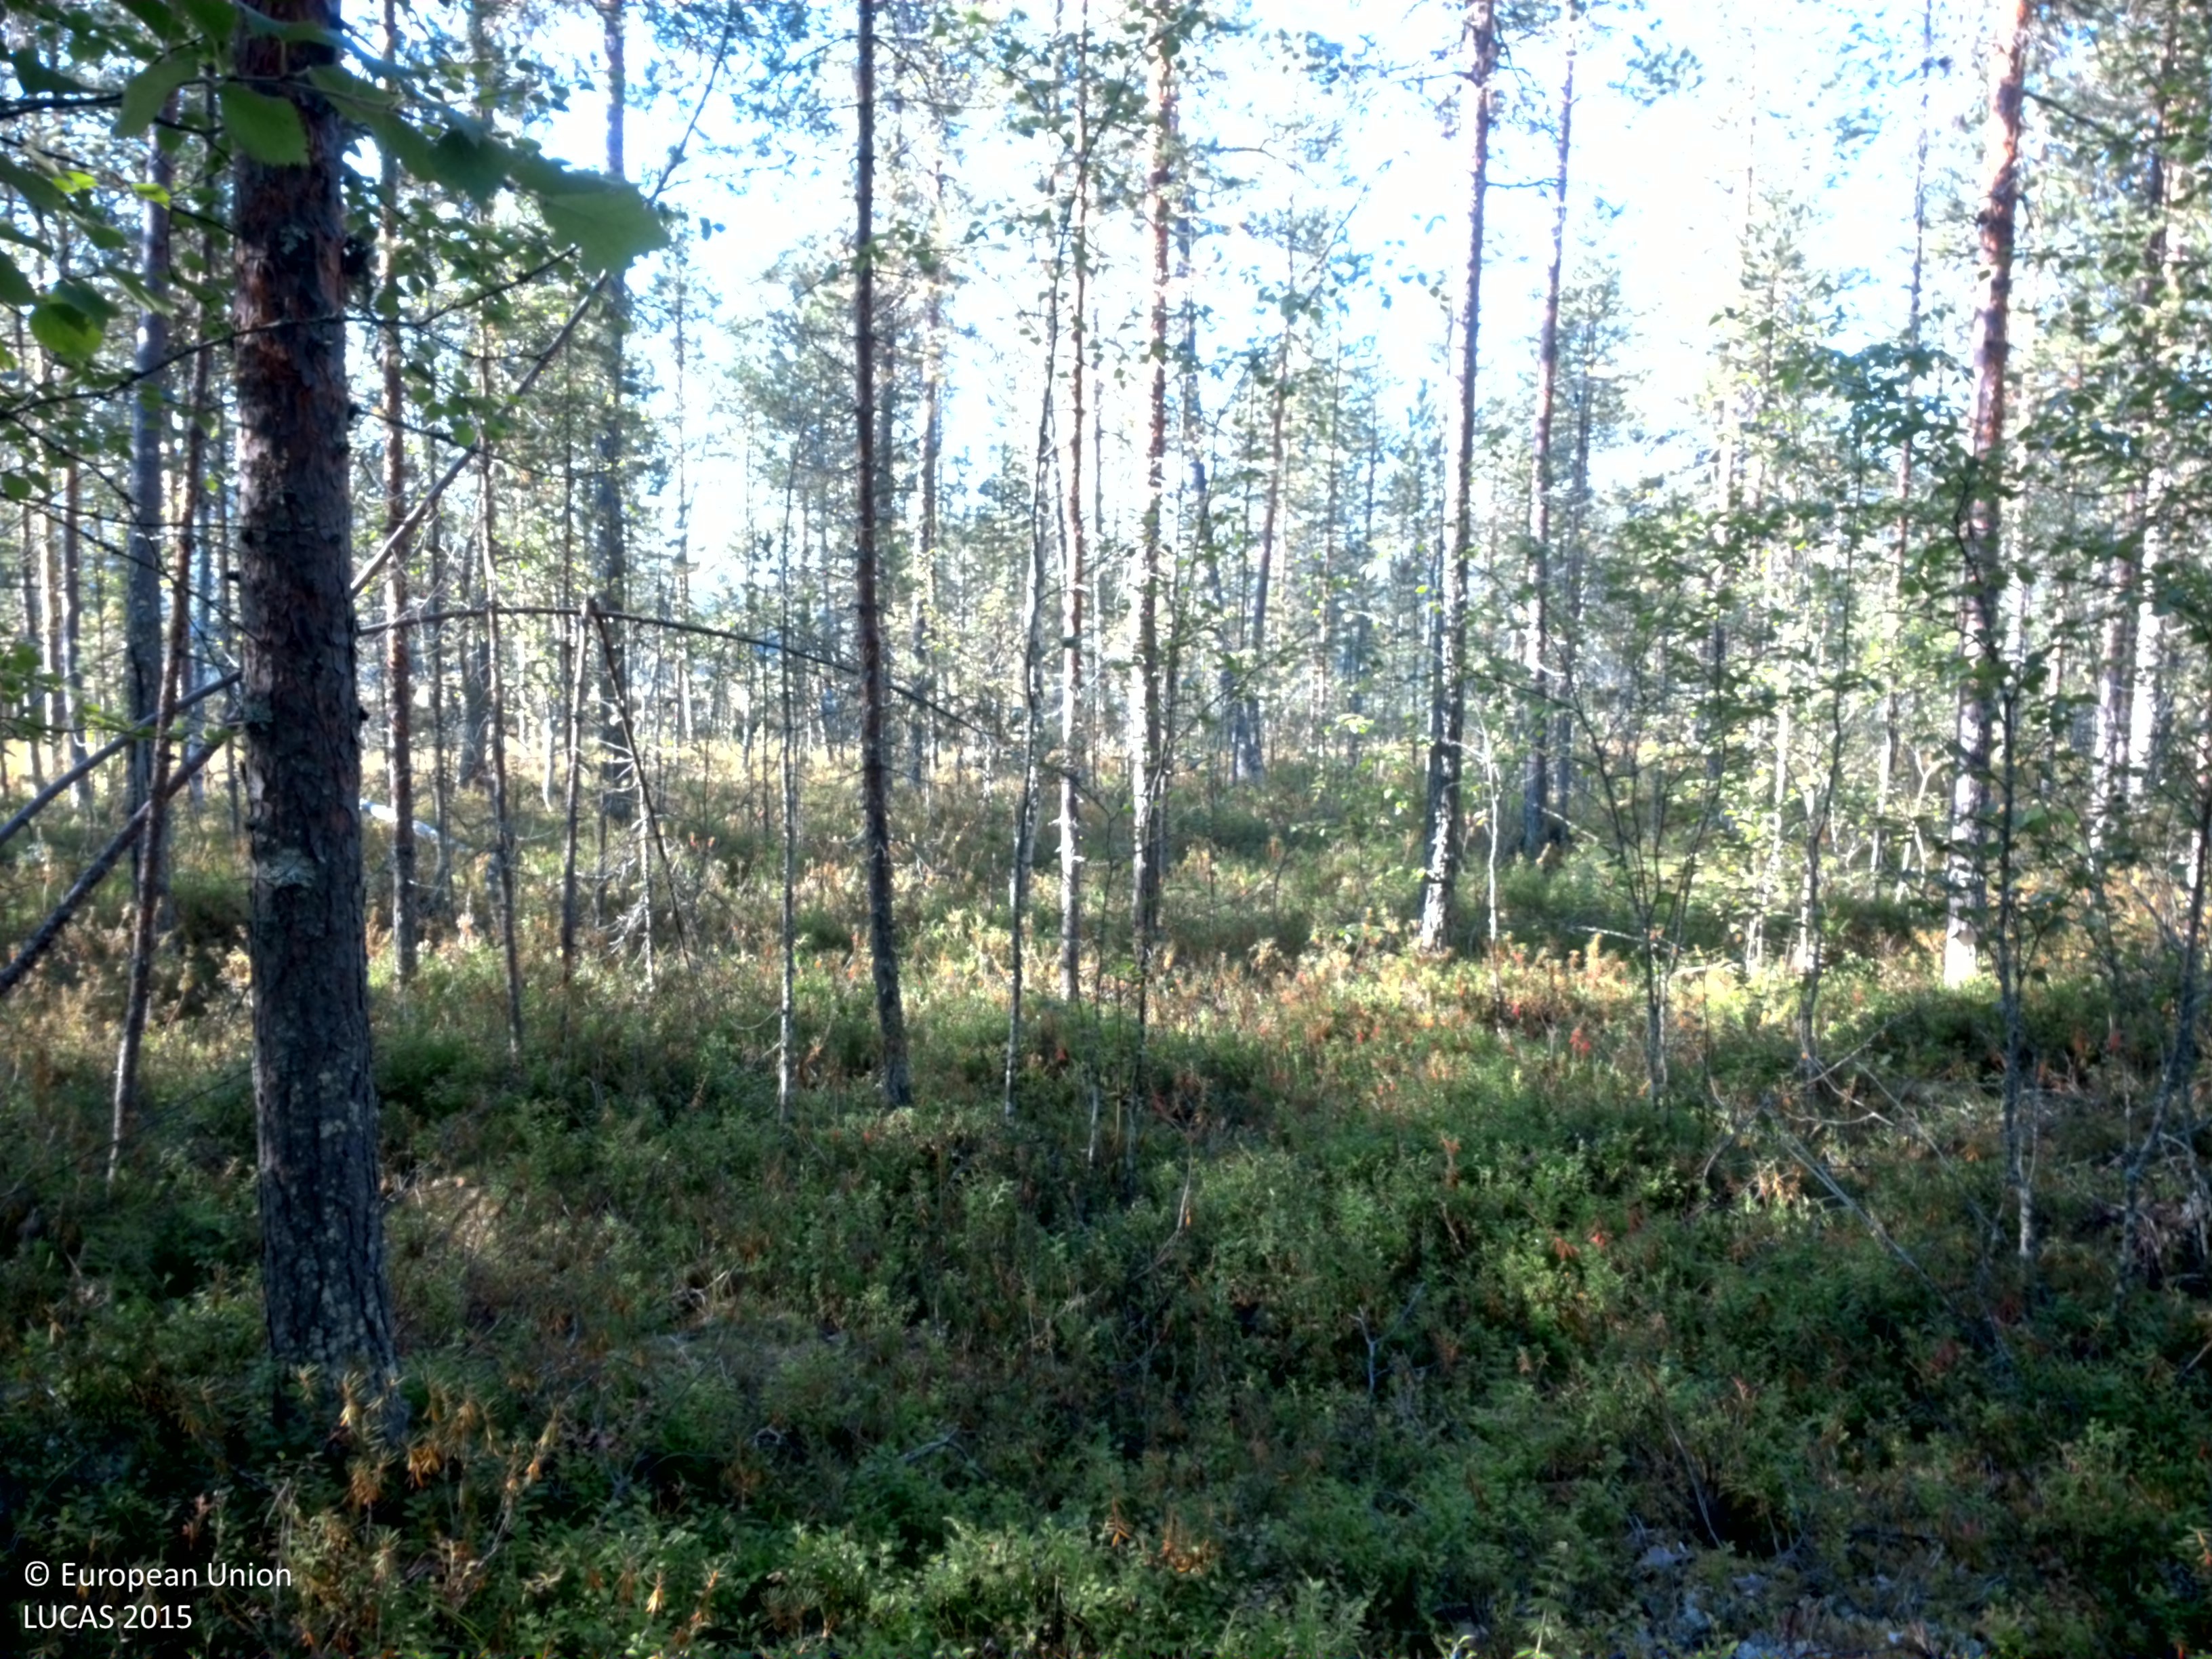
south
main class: Woodland
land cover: Pine dominated mixed woodland
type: boreal forest
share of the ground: 50 - 75 %
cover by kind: coniferous forest trees 45 %, shrubs 35 %, broadleaved forest trees 15 %, lichens and mosses 5 %
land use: Forestry
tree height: > 5 m
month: August
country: SE
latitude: 64.5542
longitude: 18.7923
